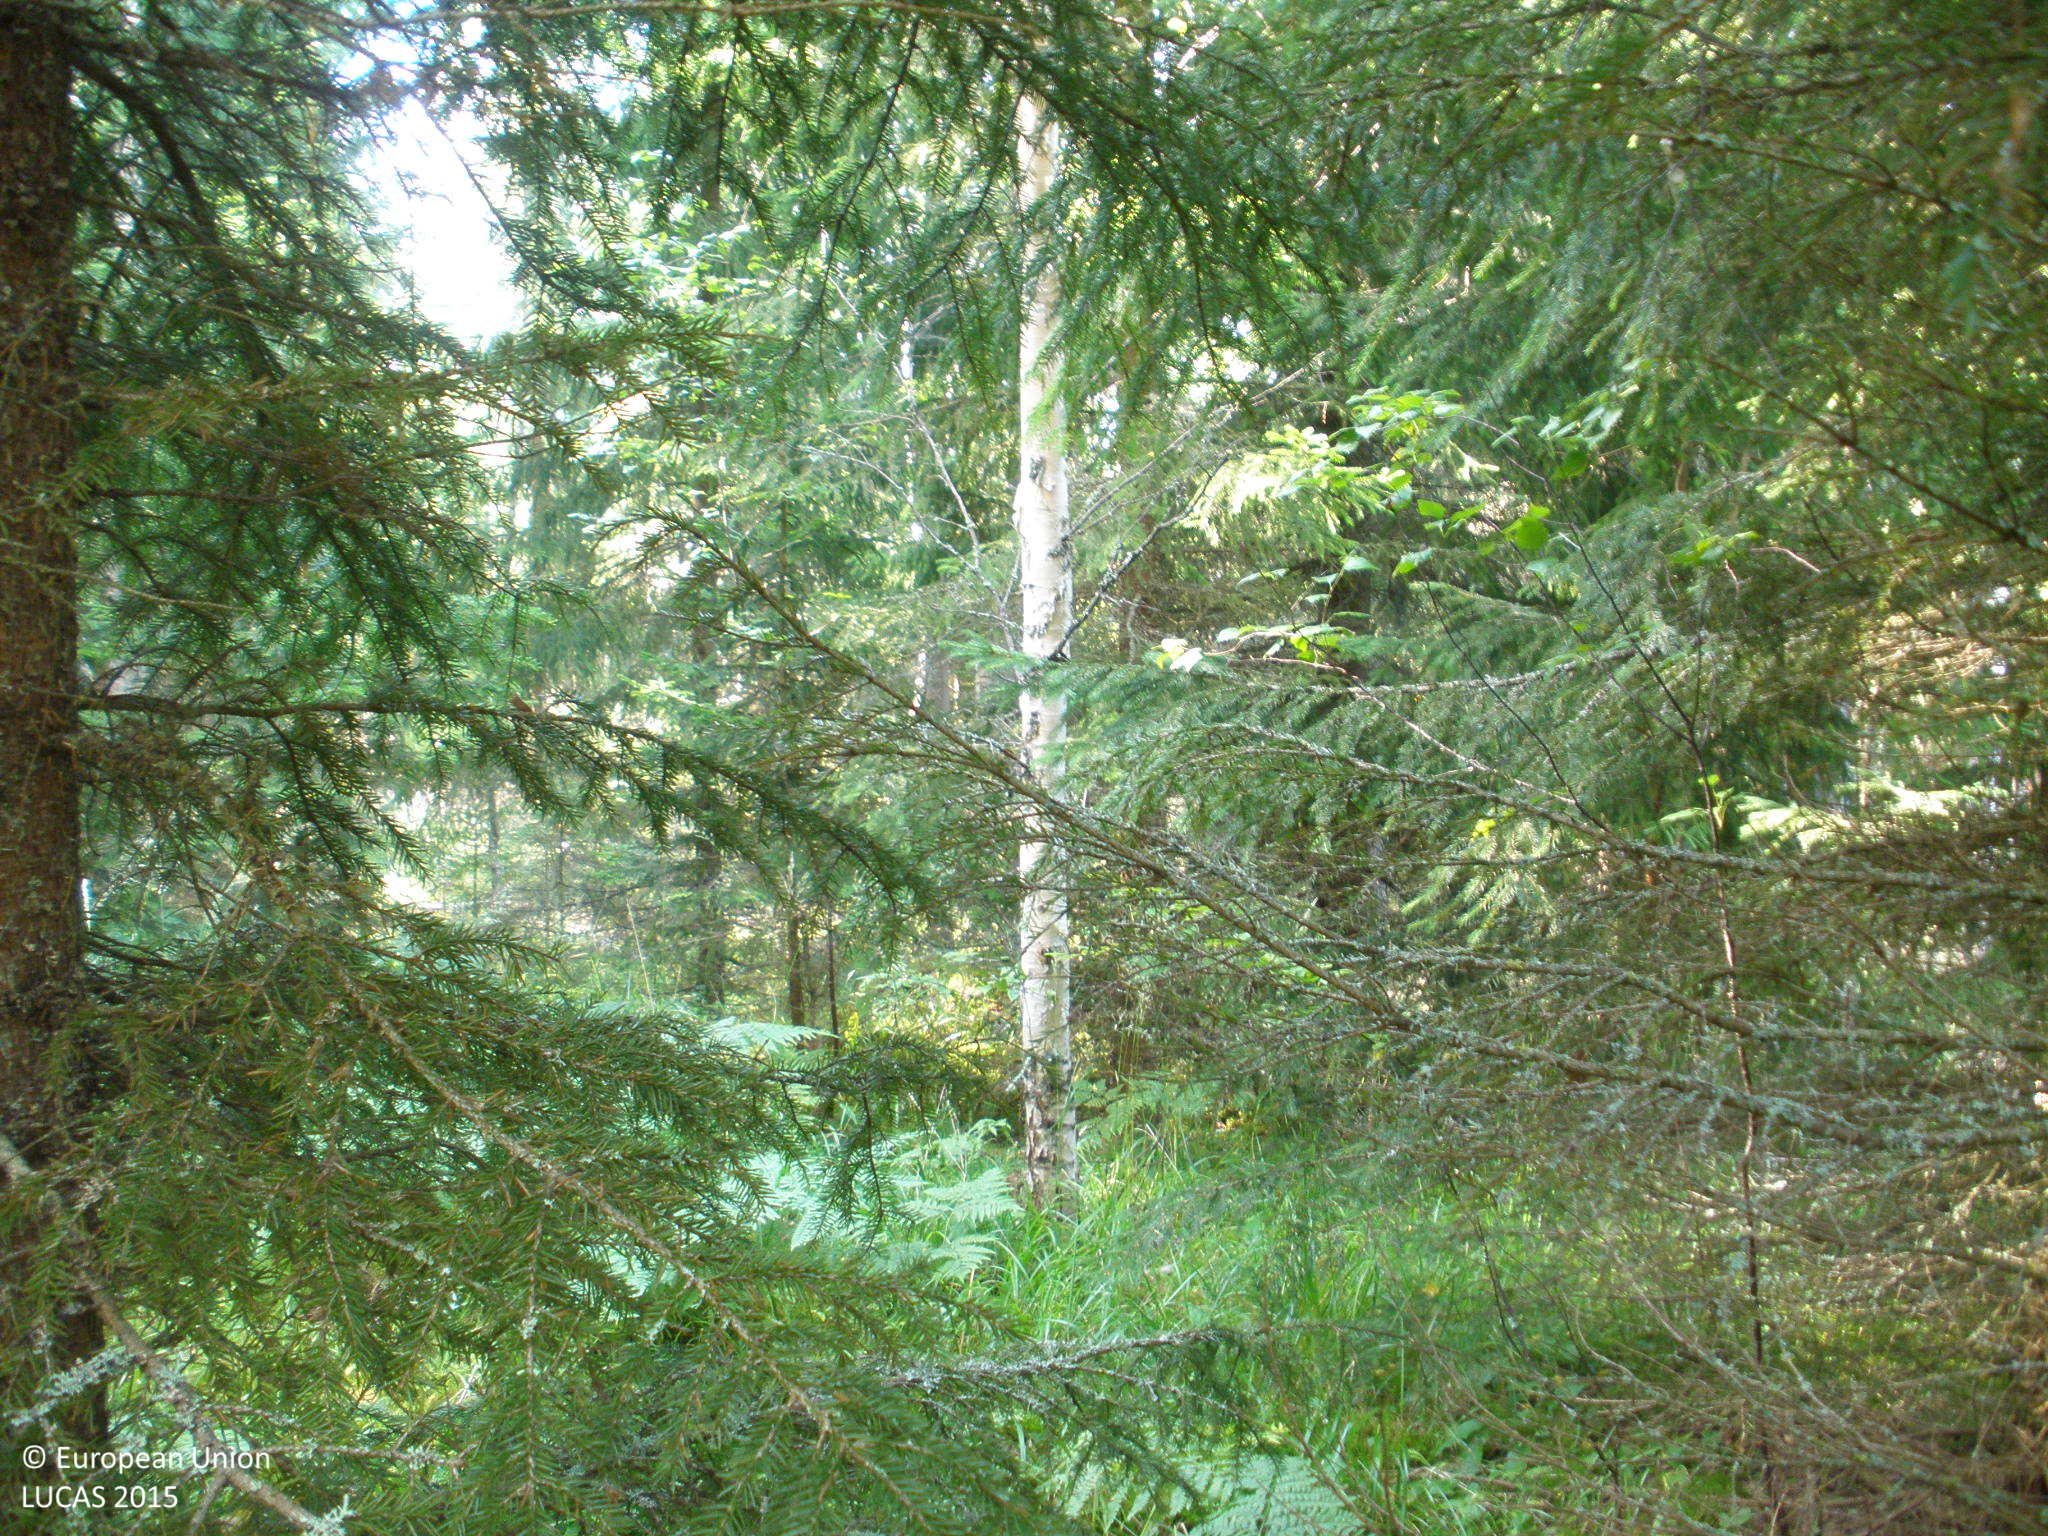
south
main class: Woodland
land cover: Spruce dominated mixed woodland
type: boreal forest
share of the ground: > 75 %
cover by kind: coniferous forest trees 65 %, broadleaved forest trees 25 %, herbaceous plants 10 %
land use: Forestry
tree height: > 5 m
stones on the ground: 10 - 25 %
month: July
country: FI
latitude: 61.1769
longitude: 24.9682
